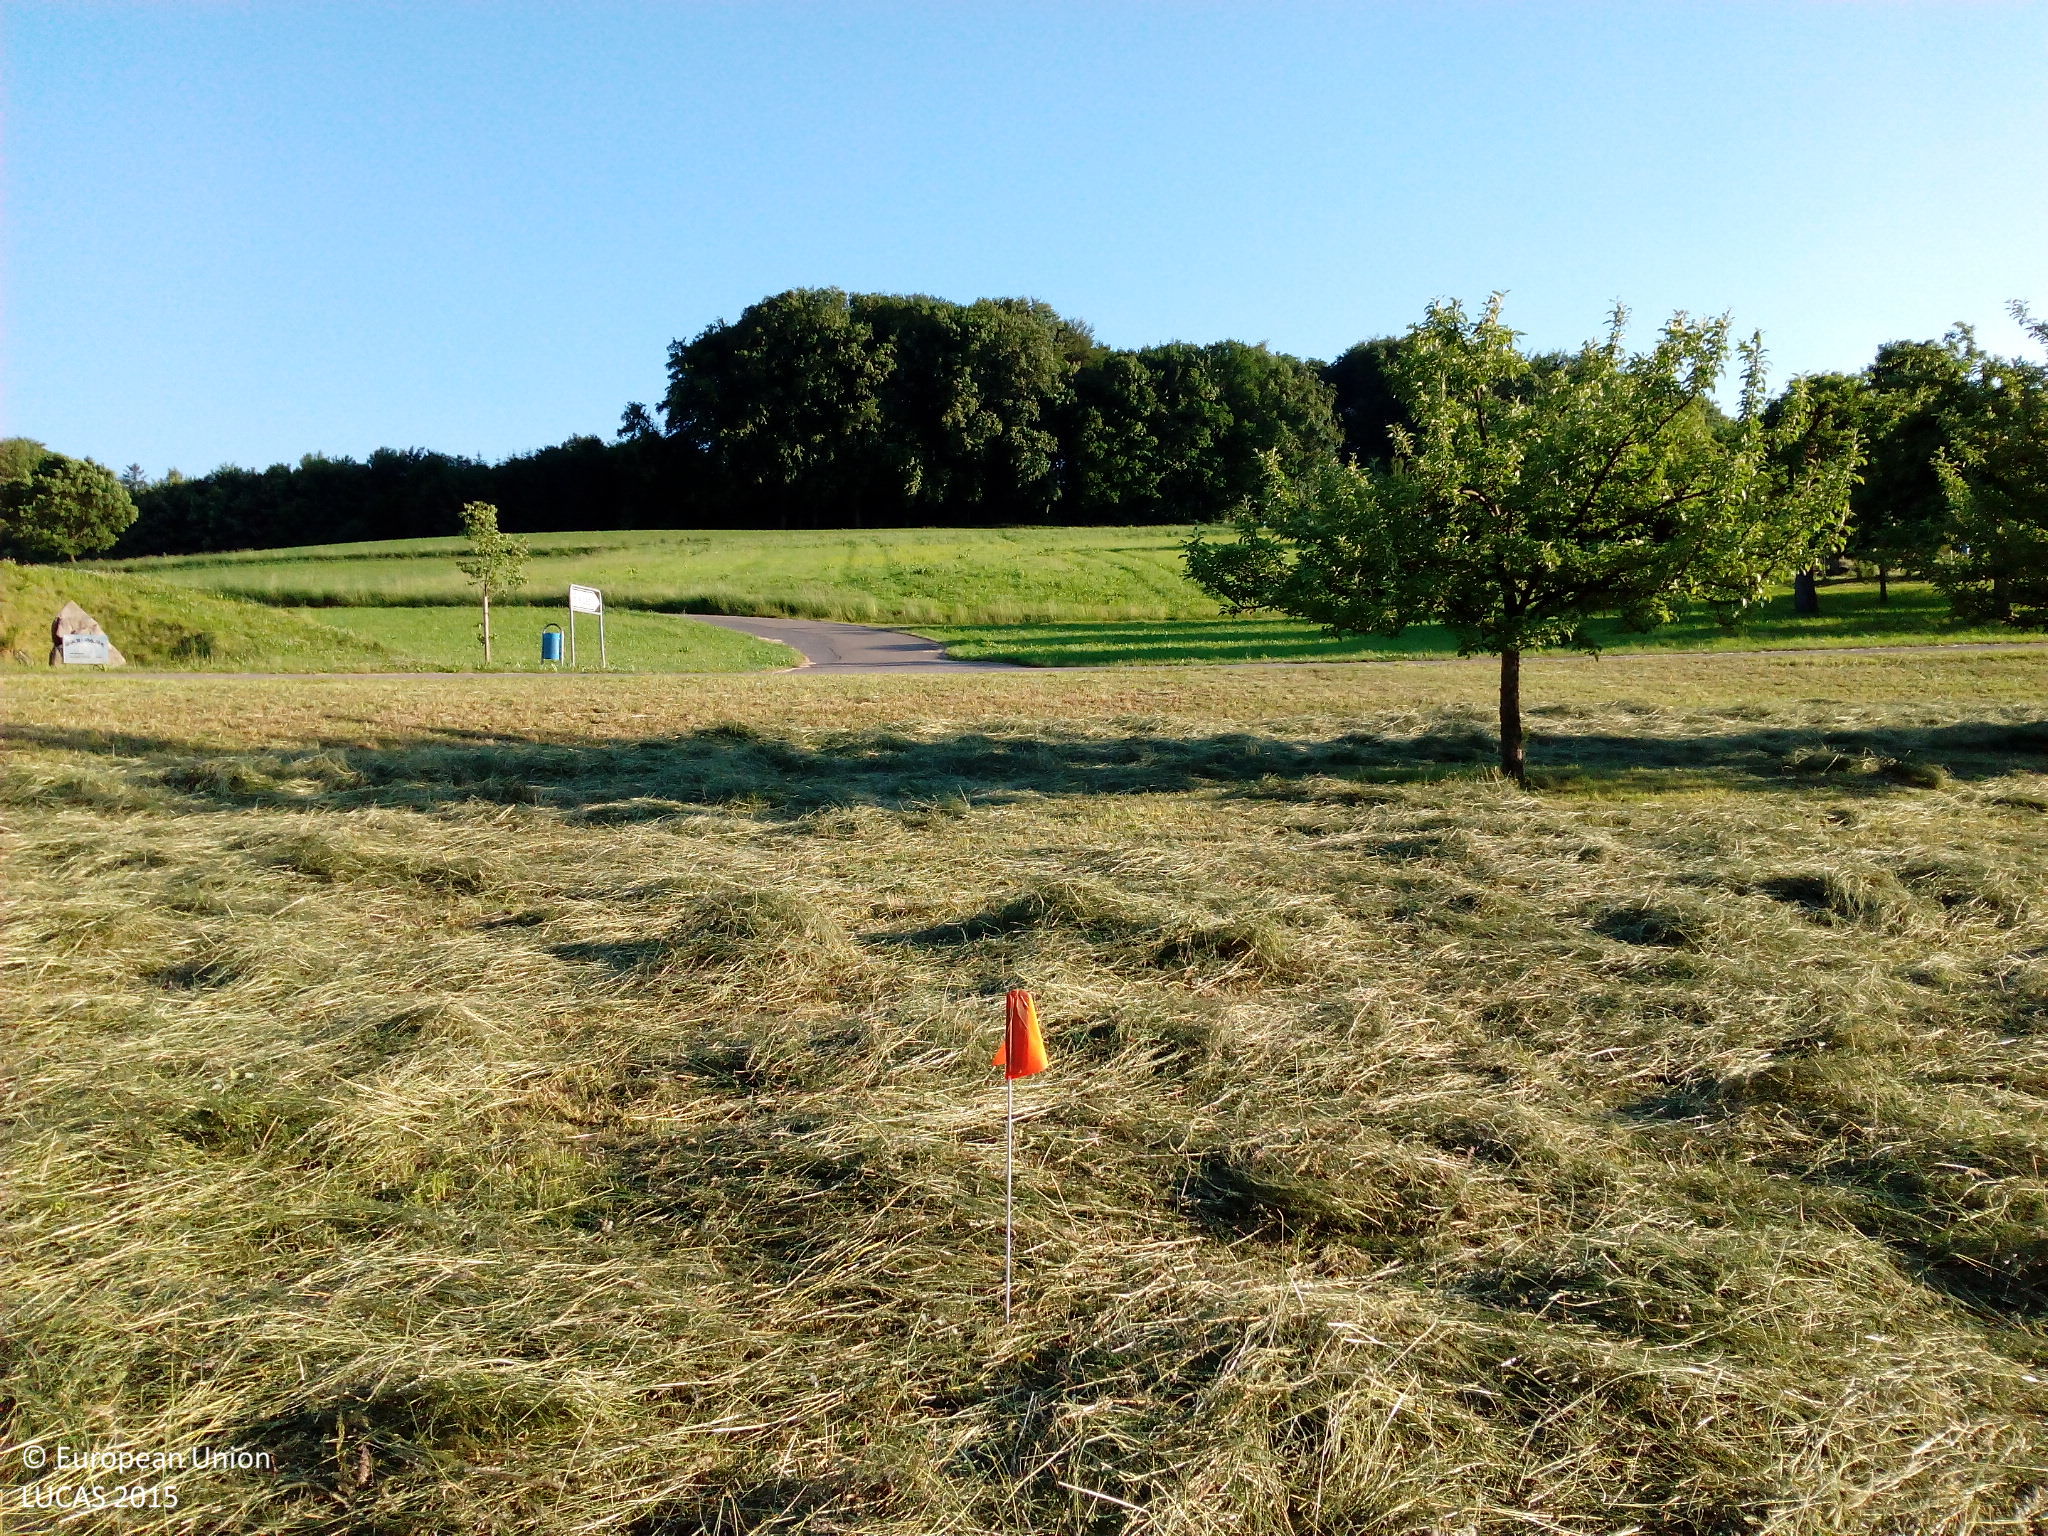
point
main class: Grassland
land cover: Grassland without tree/shrub cover
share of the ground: > 75 %
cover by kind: herbaceous plants 100 %
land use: Agriculture (excluding fallow land and kitchen gardens)
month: June
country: DE
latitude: 48.9235
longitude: 9.3861
